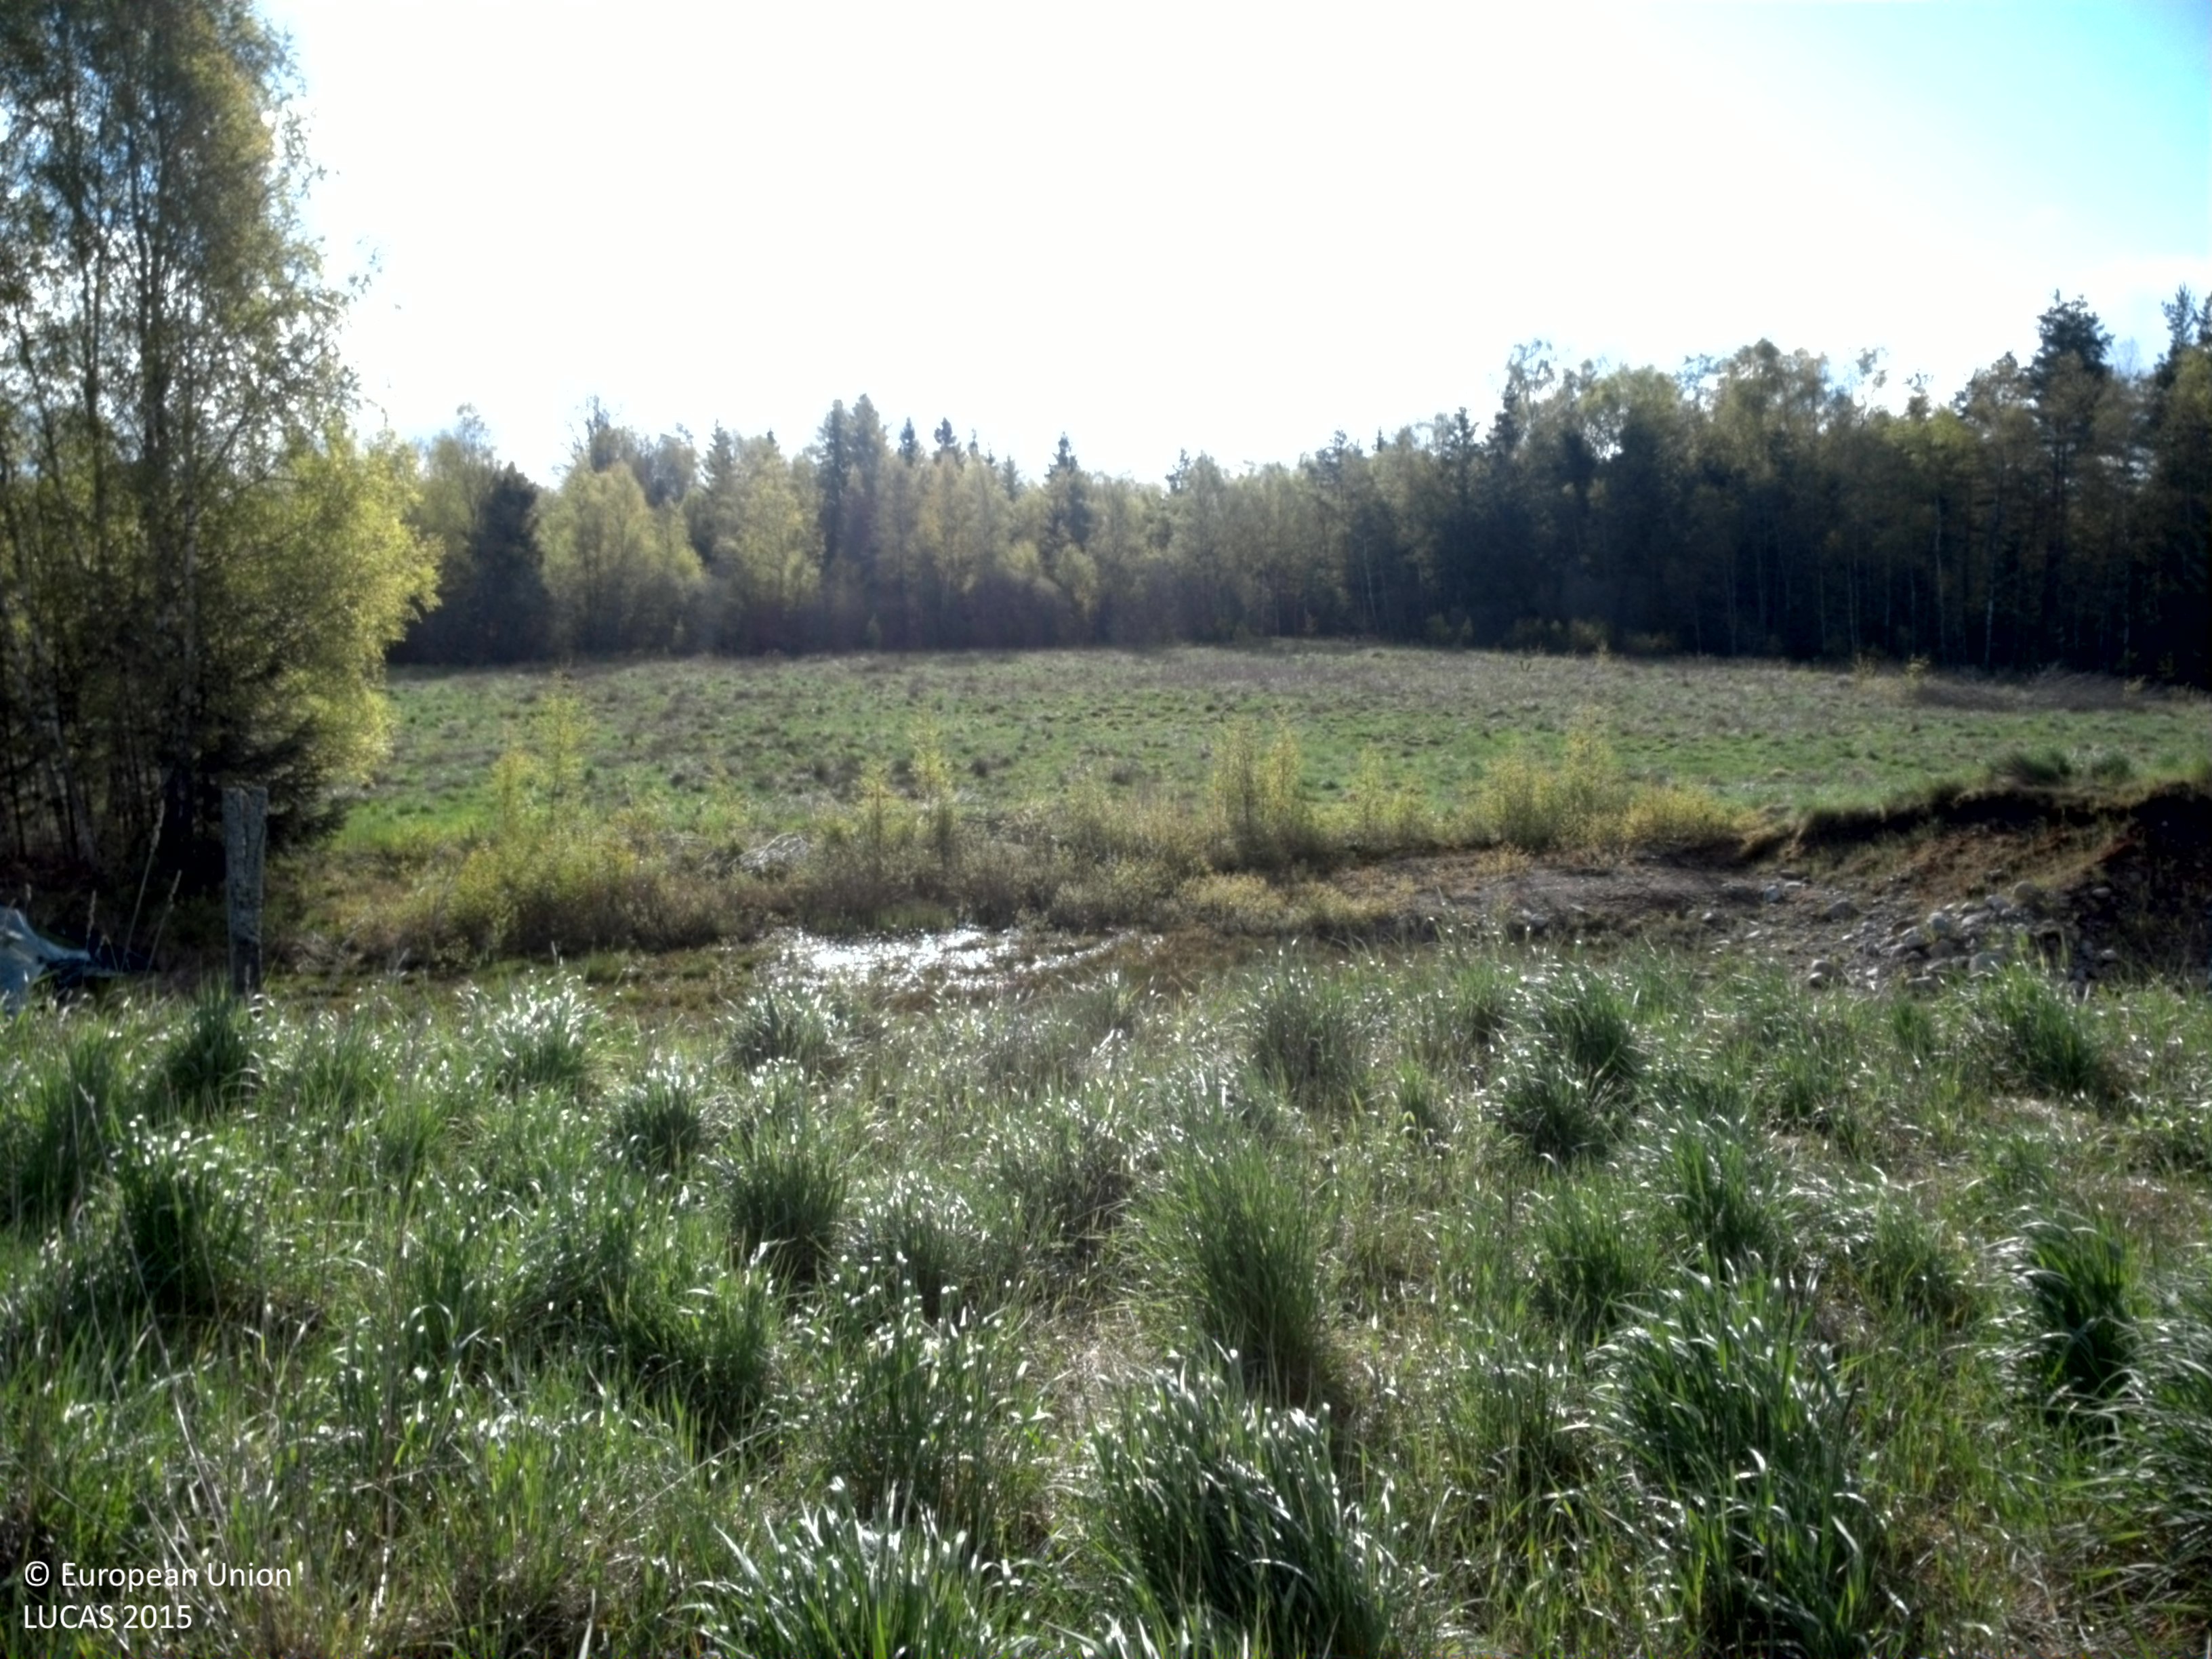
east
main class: Grassland
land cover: Grassland without tree/shrub cover
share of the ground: > 75 %
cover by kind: herbaceous plants 100 %
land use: Agriculture (excluding fallow land and kitchen gardens)
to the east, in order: Grassland without tree/shrub cover; Grassland with sparse tree/shrub cover; Grassland without tree/shrub cover; Ditches and canals; Broadleaved woodland; Grassland with sparse tree/shrub cover; Broadleaved woodland; Dry stone walls; Broadleaved woodland; Ditches and canals; Broadleaved woodland
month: May
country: SE
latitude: 56.8342
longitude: 14.8651
